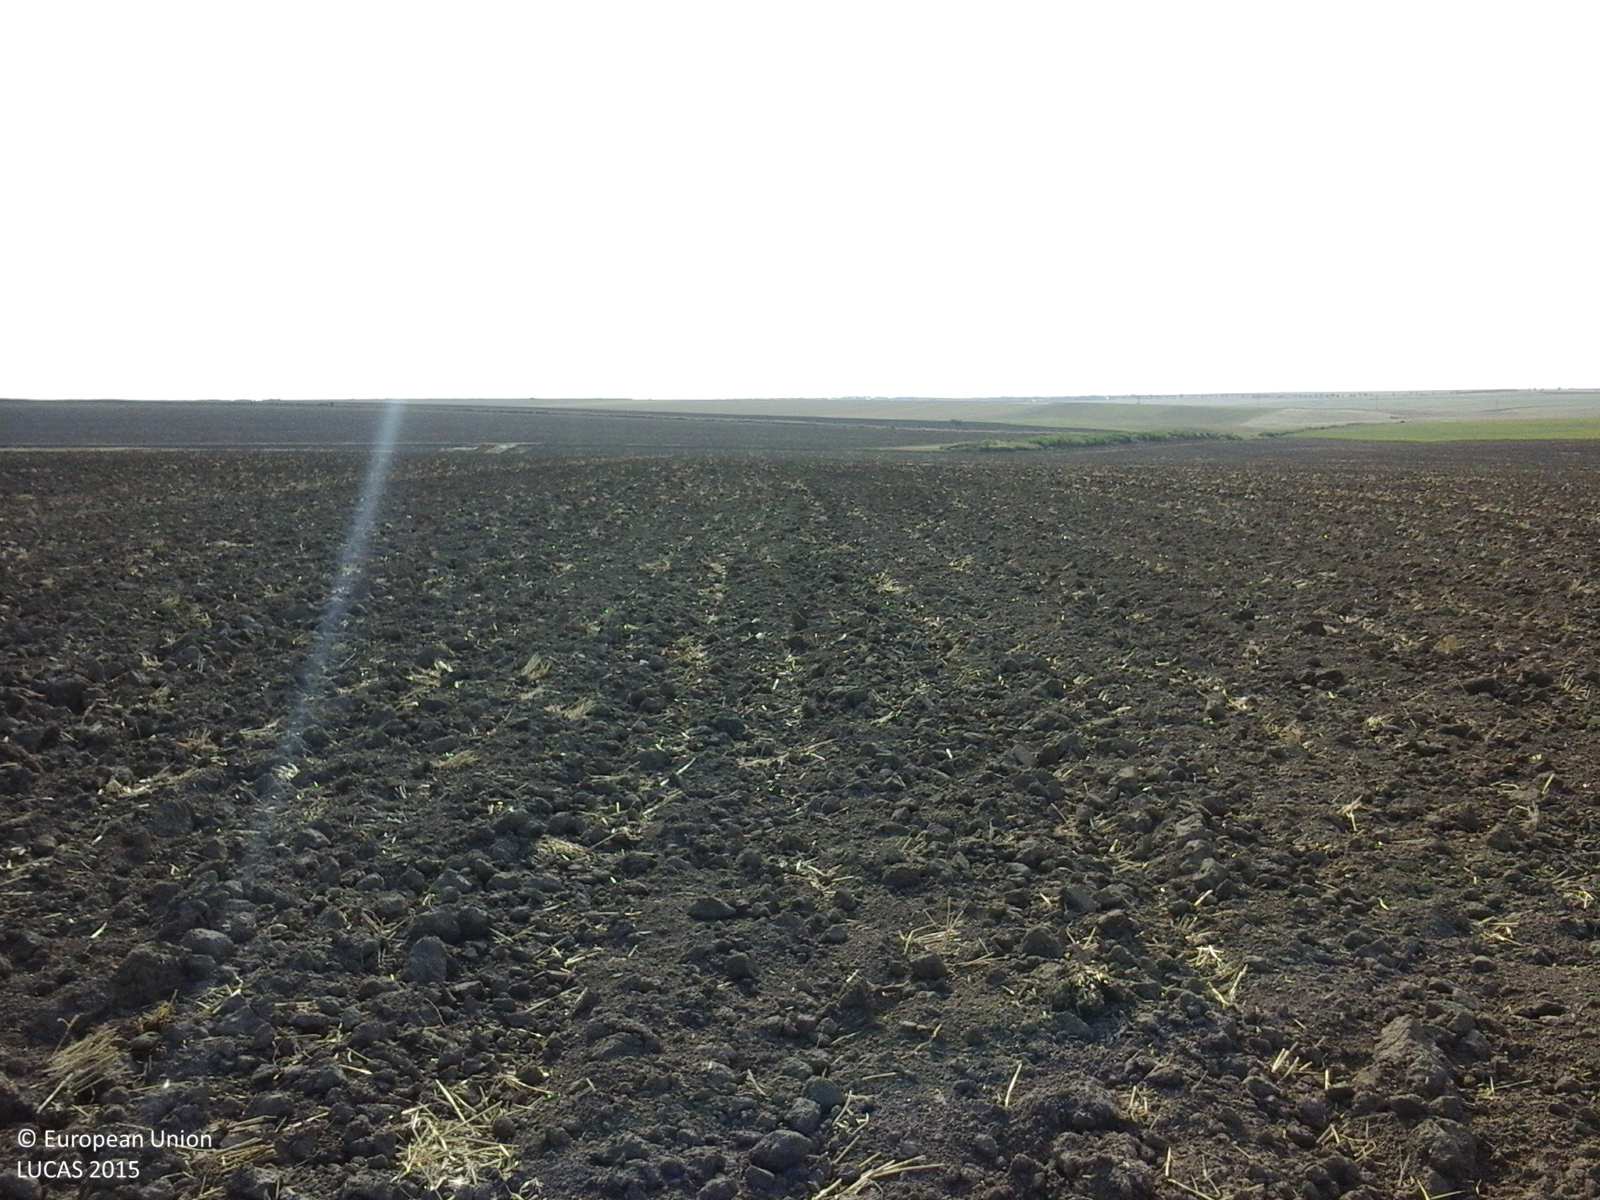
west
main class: Cropland
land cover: Common wheat
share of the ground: < 10 %
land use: Agriculture (excluding fallow land and kitchen gardens)
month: August
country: RO
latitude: 44.1103
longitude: 28.3943
